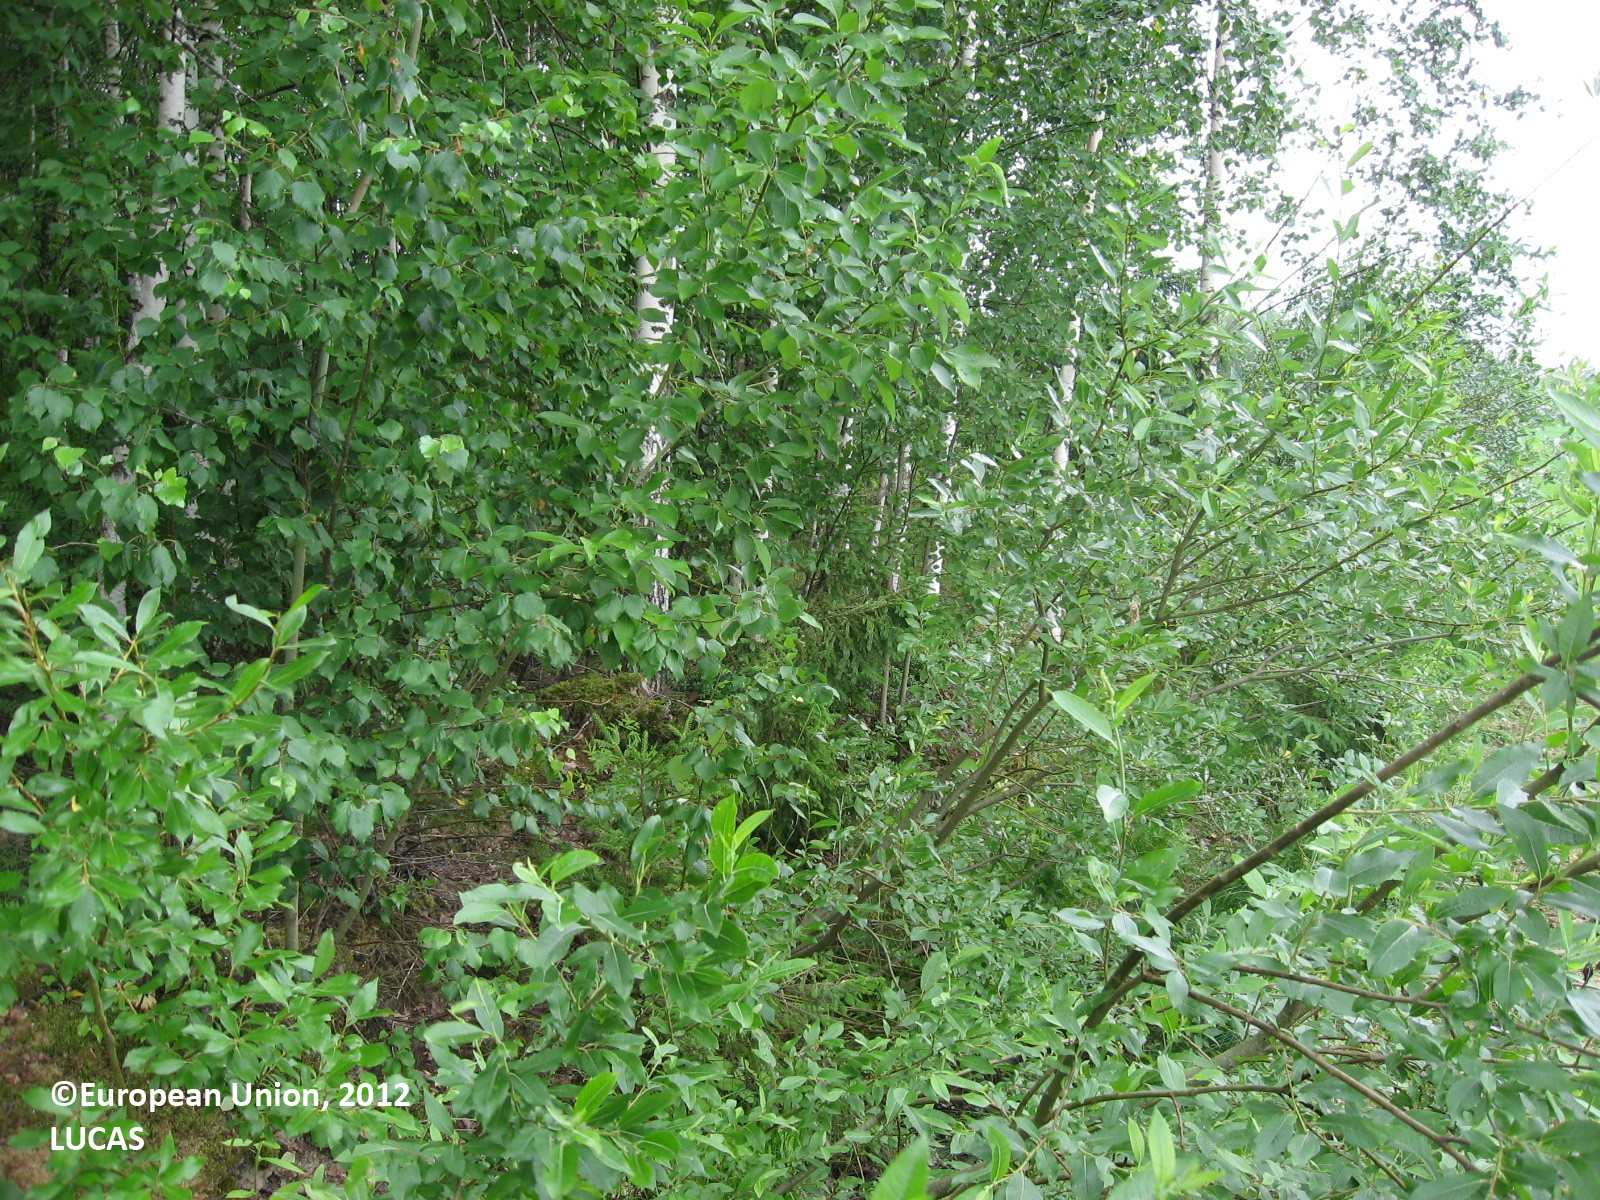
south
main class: Cropland
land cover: Oats
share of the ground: 50 - 75 %
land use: Agriculture (excluding fallow land and kitchen gardens)
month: July
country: FI
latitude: 60.8854
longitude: 25.6245
